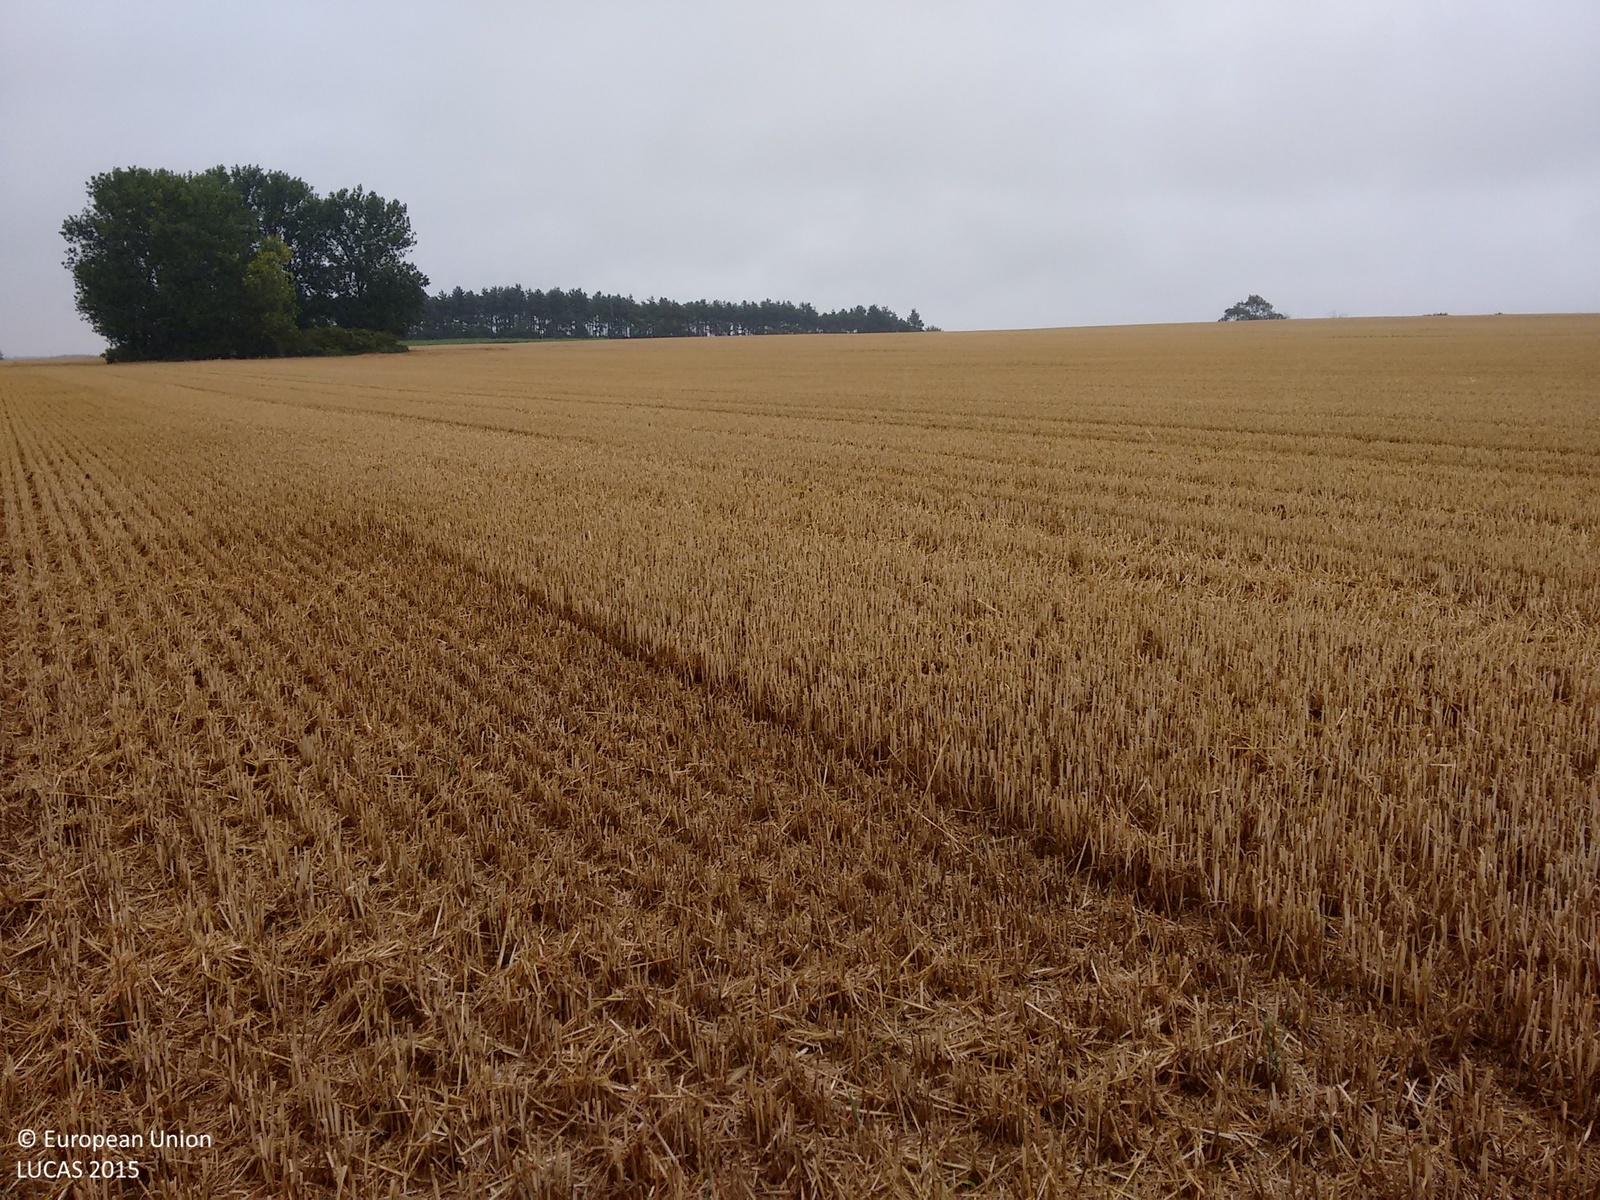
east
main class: Cropland
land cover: Common wheat
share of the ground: > 75 %
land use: Agriculture (excluding fallow land and kitchen gardens)
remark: Harvested field
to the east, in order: Common wheat
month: August
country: GB
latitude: 52.7773
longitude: 0.7692
